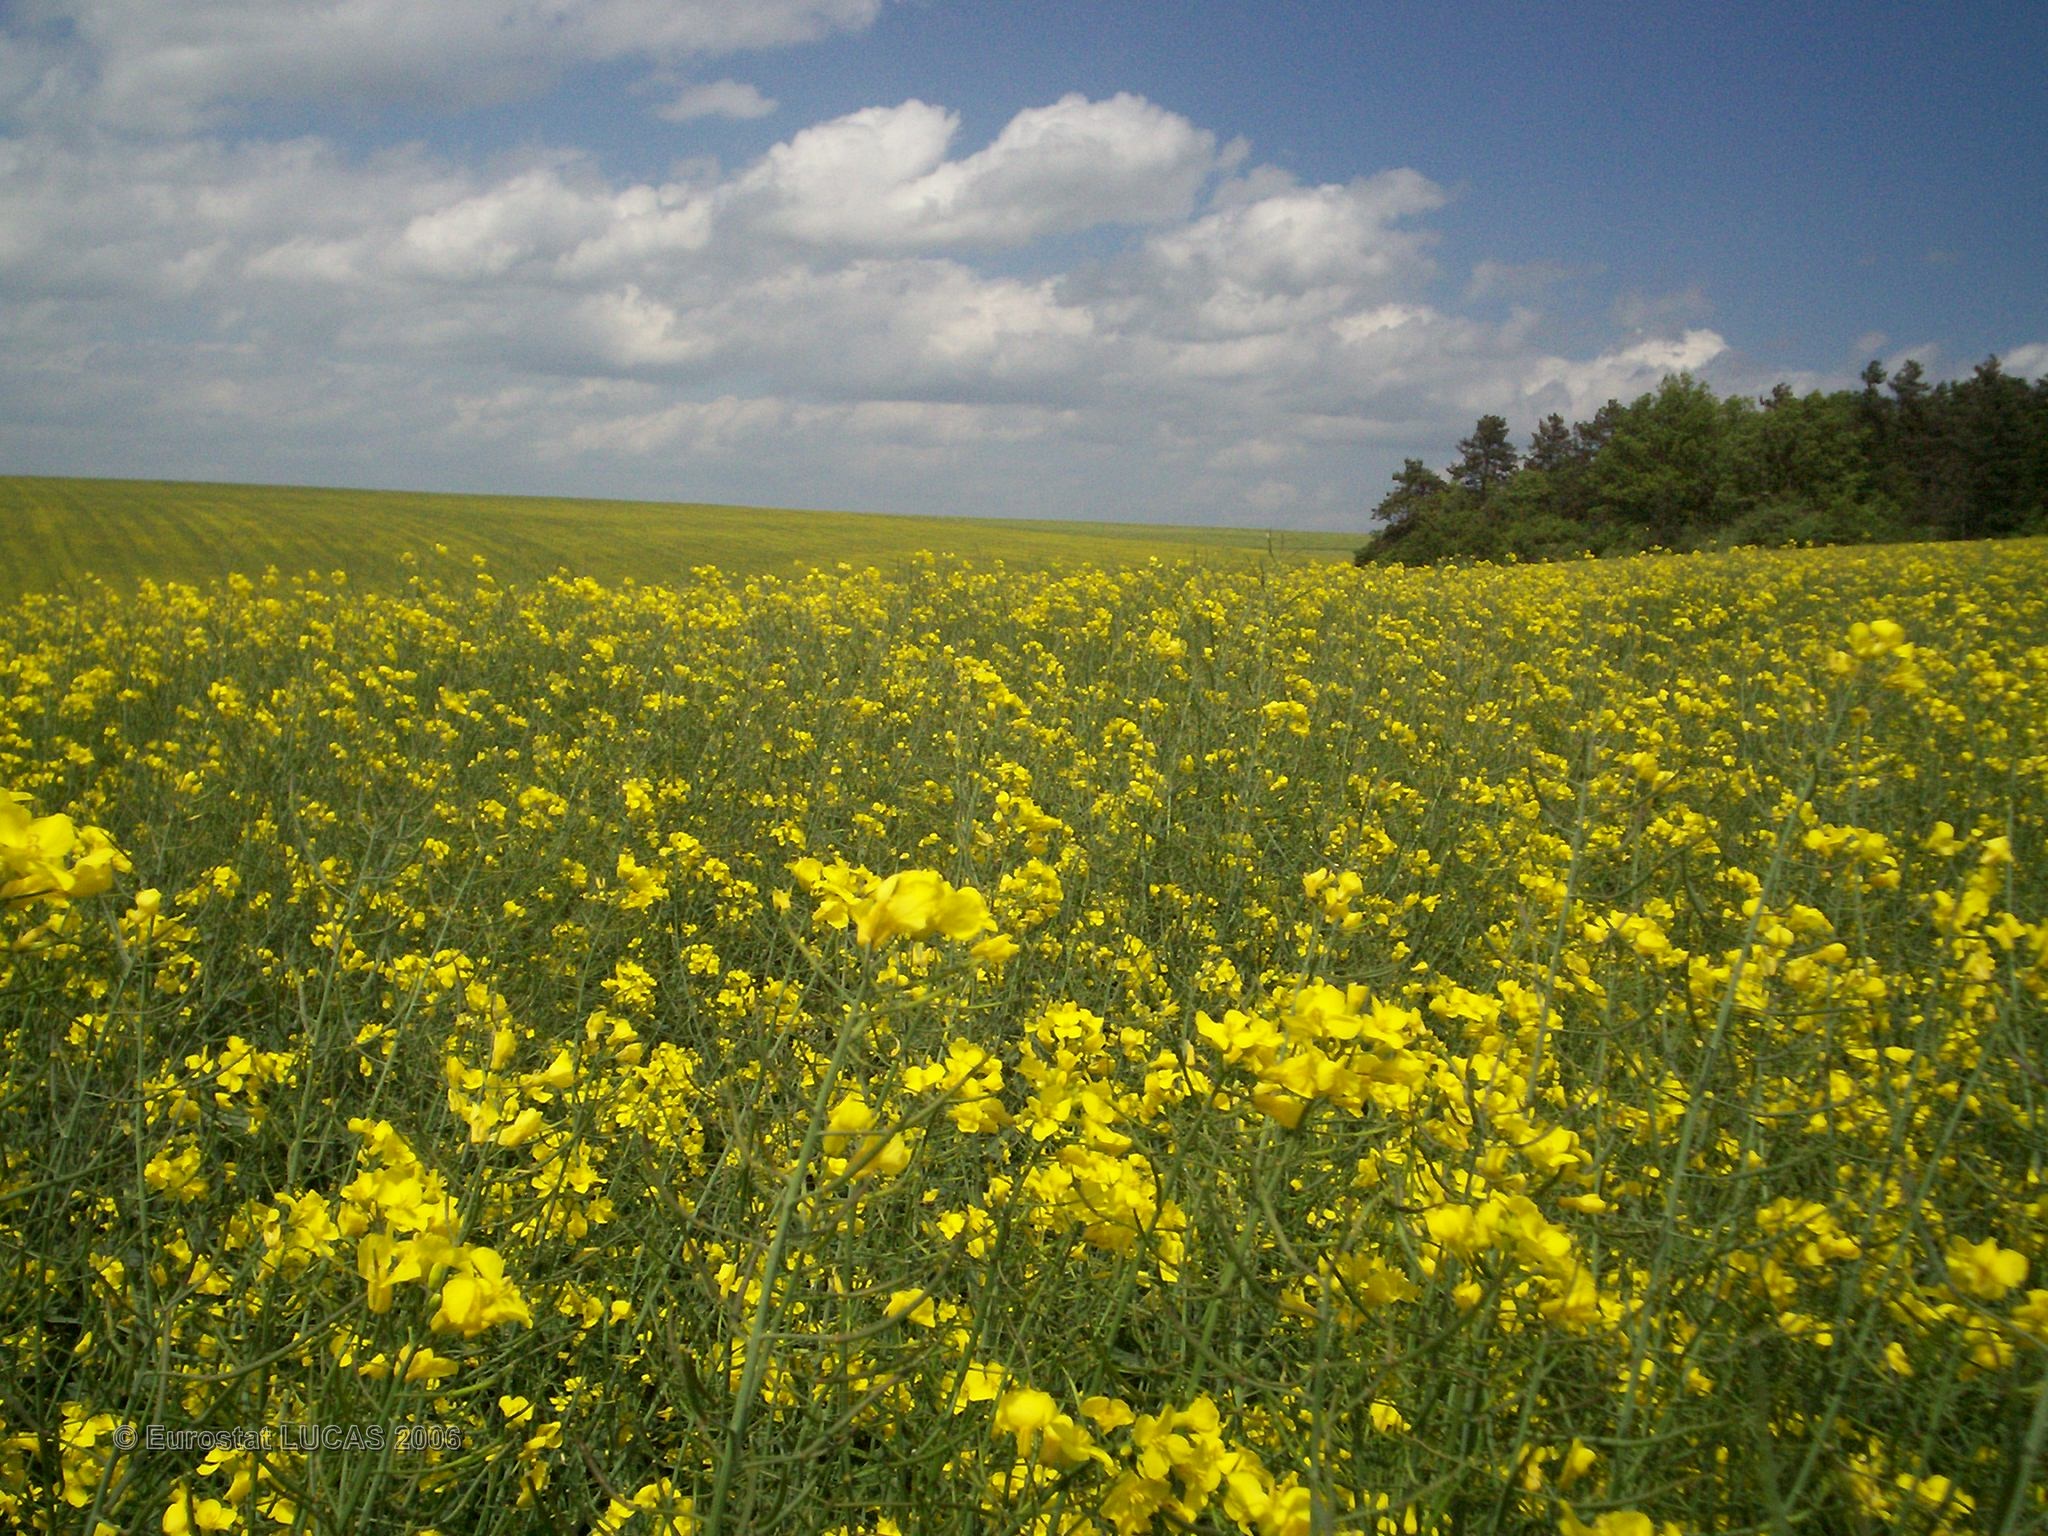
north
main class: Cropland
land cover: Rape and turnip rape
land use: Agriculture (excluding fallow land and kitchen gardens)
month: May
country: FR
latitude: 47.6491
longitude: 4.0735
